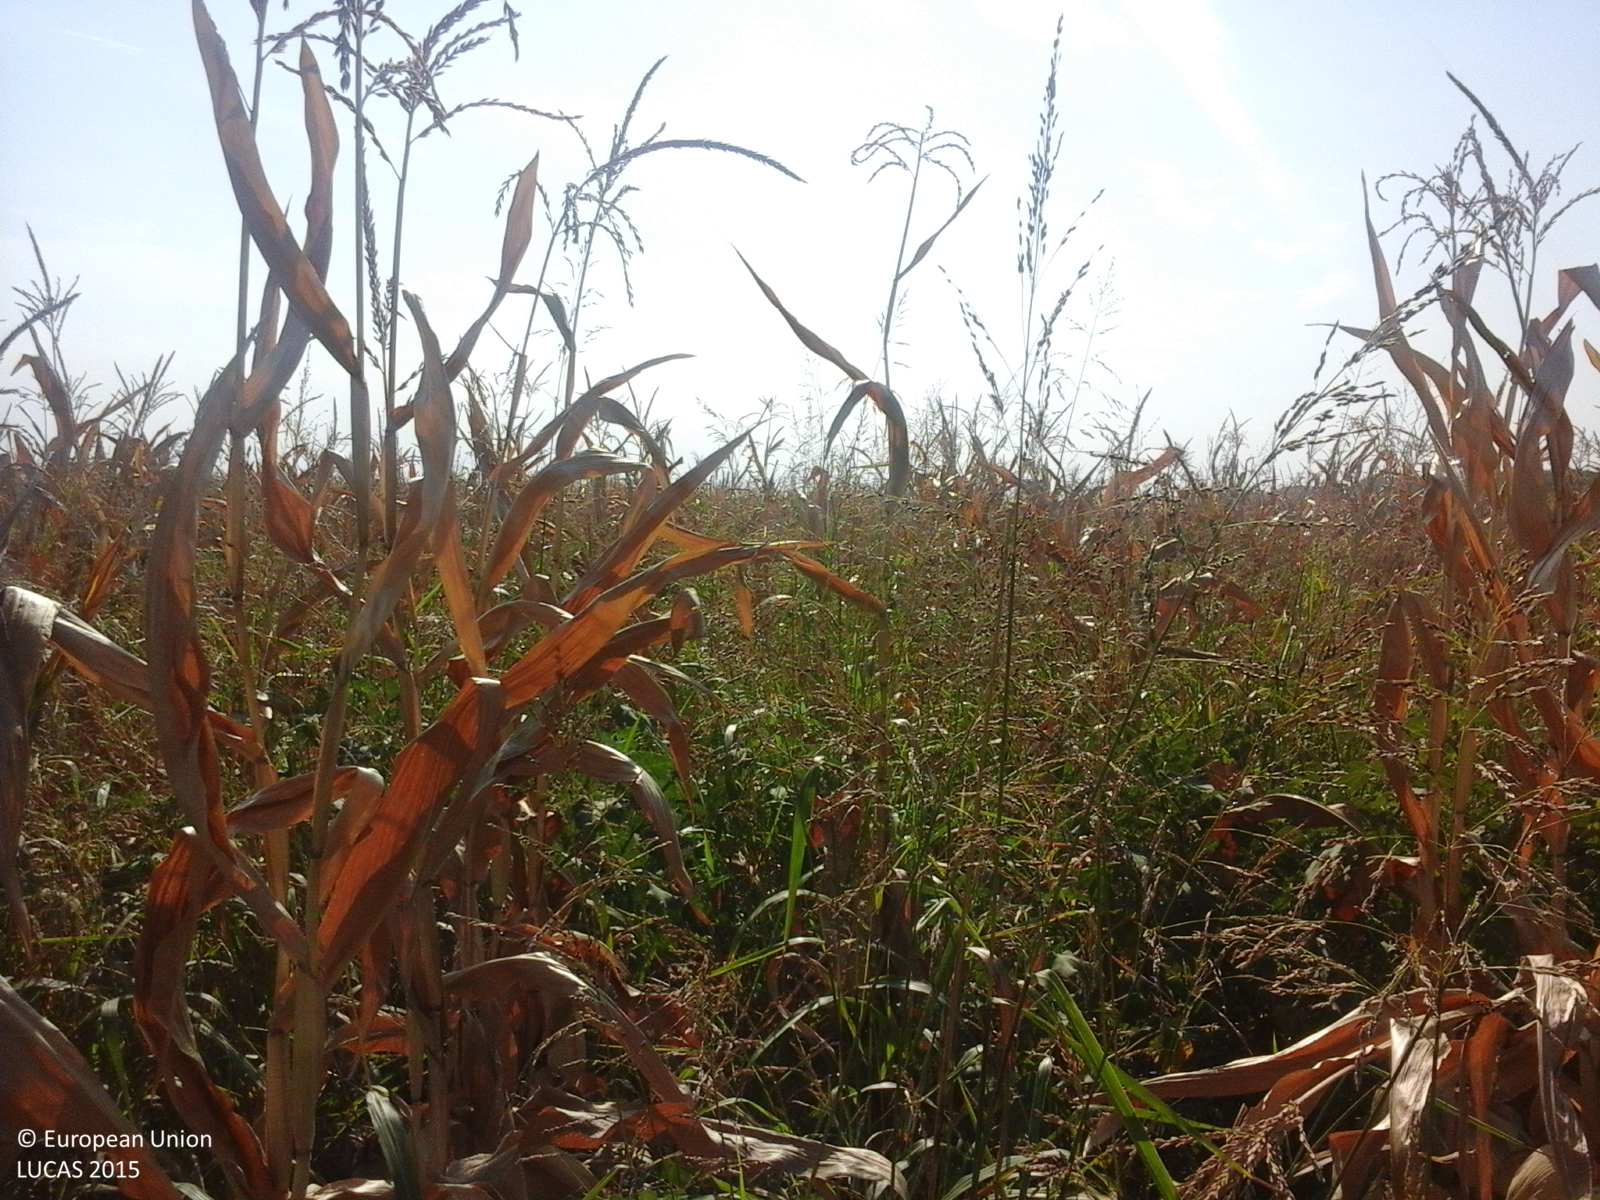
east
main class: Cropland
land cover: Maize
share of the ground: 50 - 75 %
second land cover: Spontaneously vegetated surfaces
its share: 50 - 75 %
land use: Agriculture (excluding fallow land and kitchen gardens)
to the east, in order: Maize; Spontaneously vegetated surfaces
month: August
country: RO
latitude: 43.8481
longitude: 23.4944
